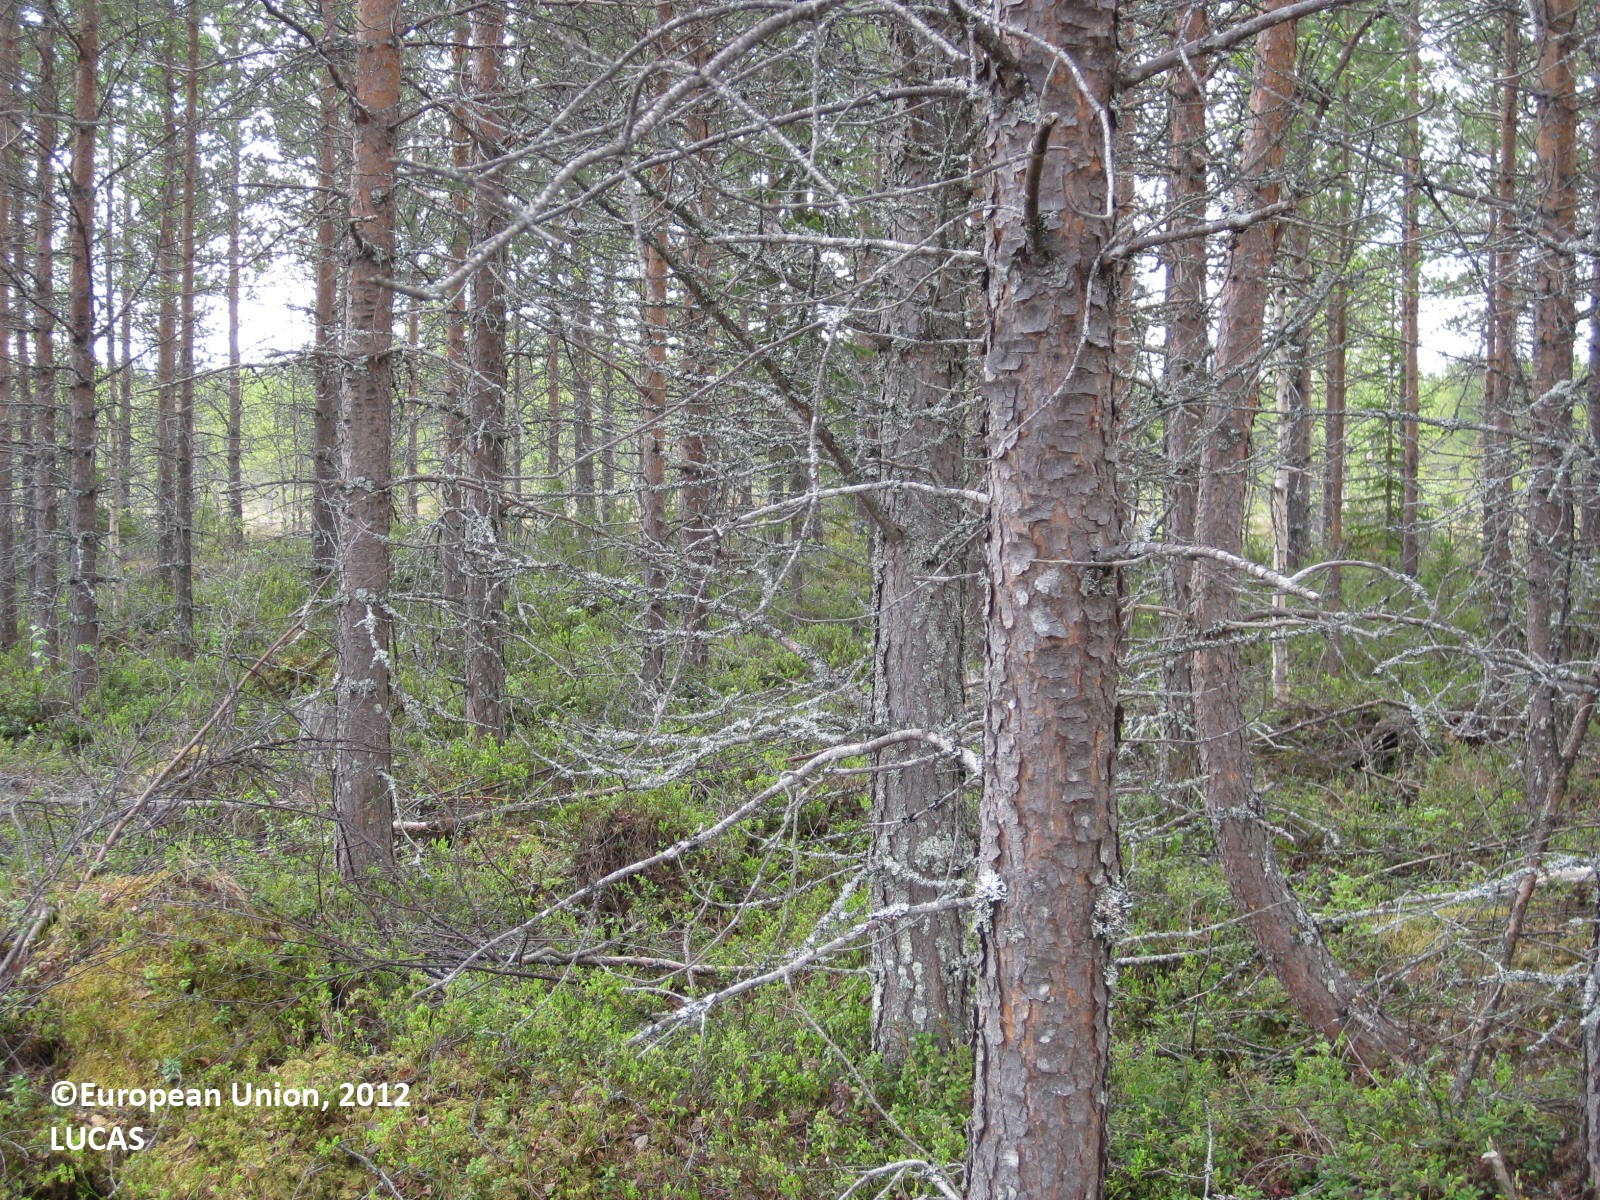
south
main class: Woodland
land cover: Pine dominated mixed woodland
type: boreal forest
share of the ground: > 75 %
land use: Forestry
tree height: > 5 m
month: June
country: FI
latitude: 65.0195
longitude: 29.5407
